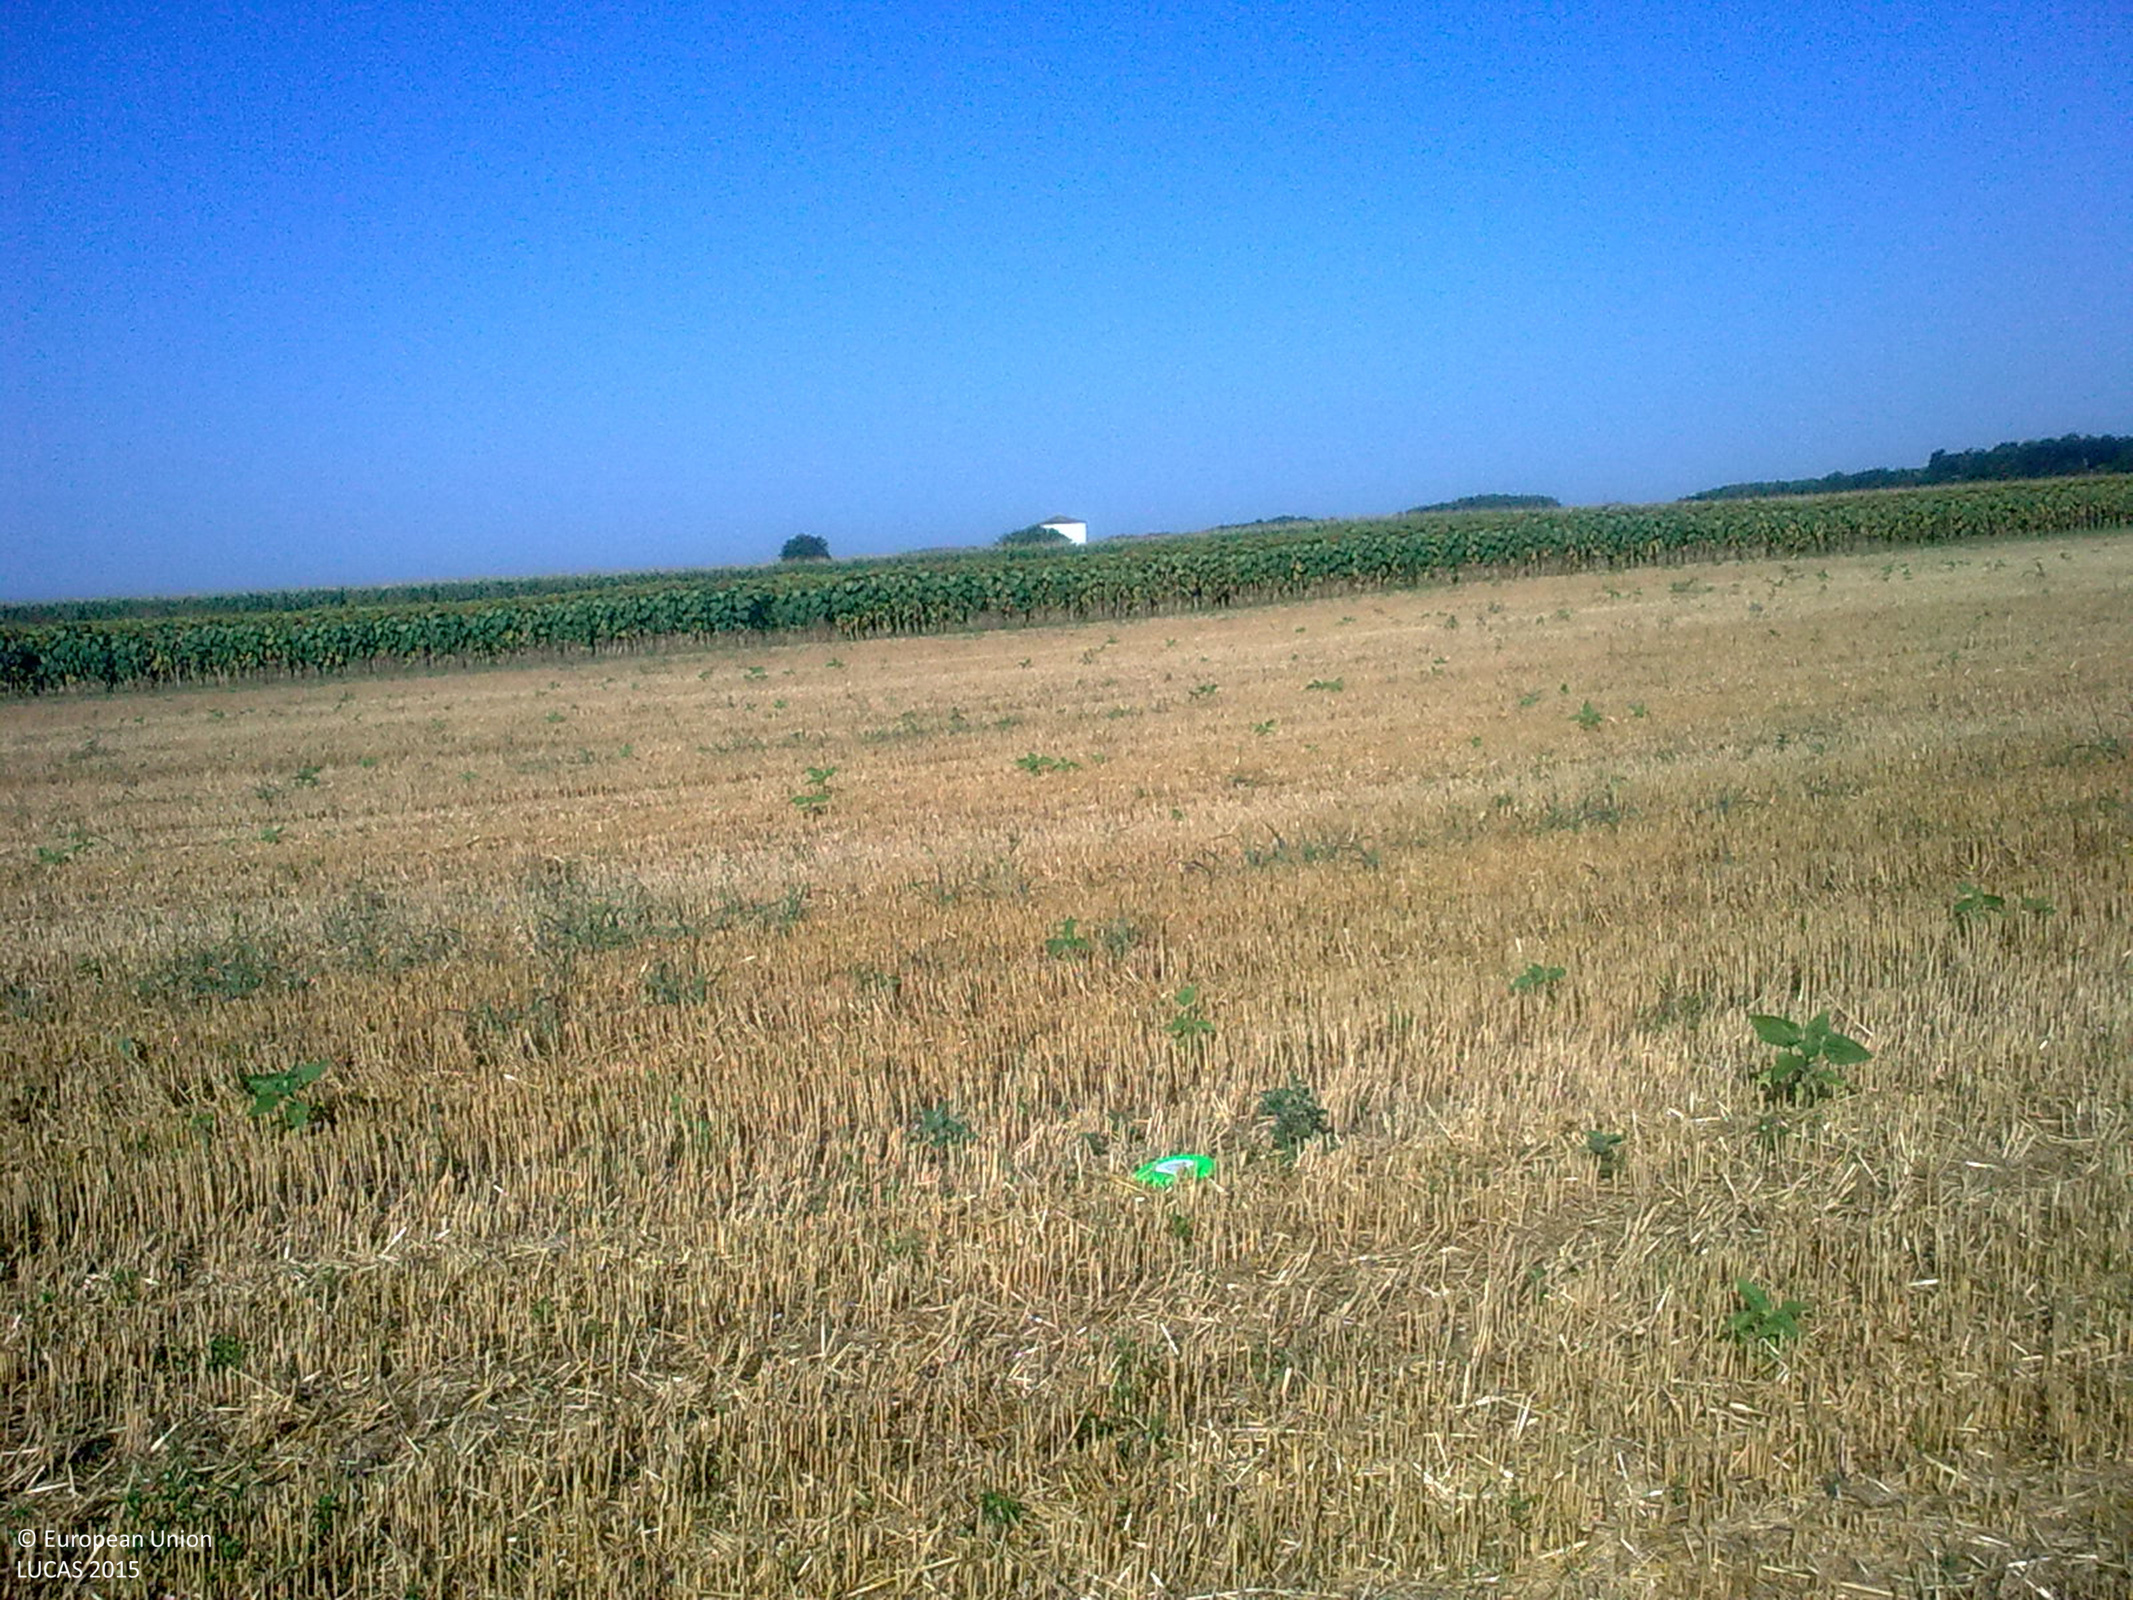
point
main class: Cropland
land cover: Common wheat
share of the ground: 50 - 75 %
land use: Agriculture (excluding fallow land and kitchen gardens)
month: July
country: BG
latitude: 43.9722
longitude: 26.1693
